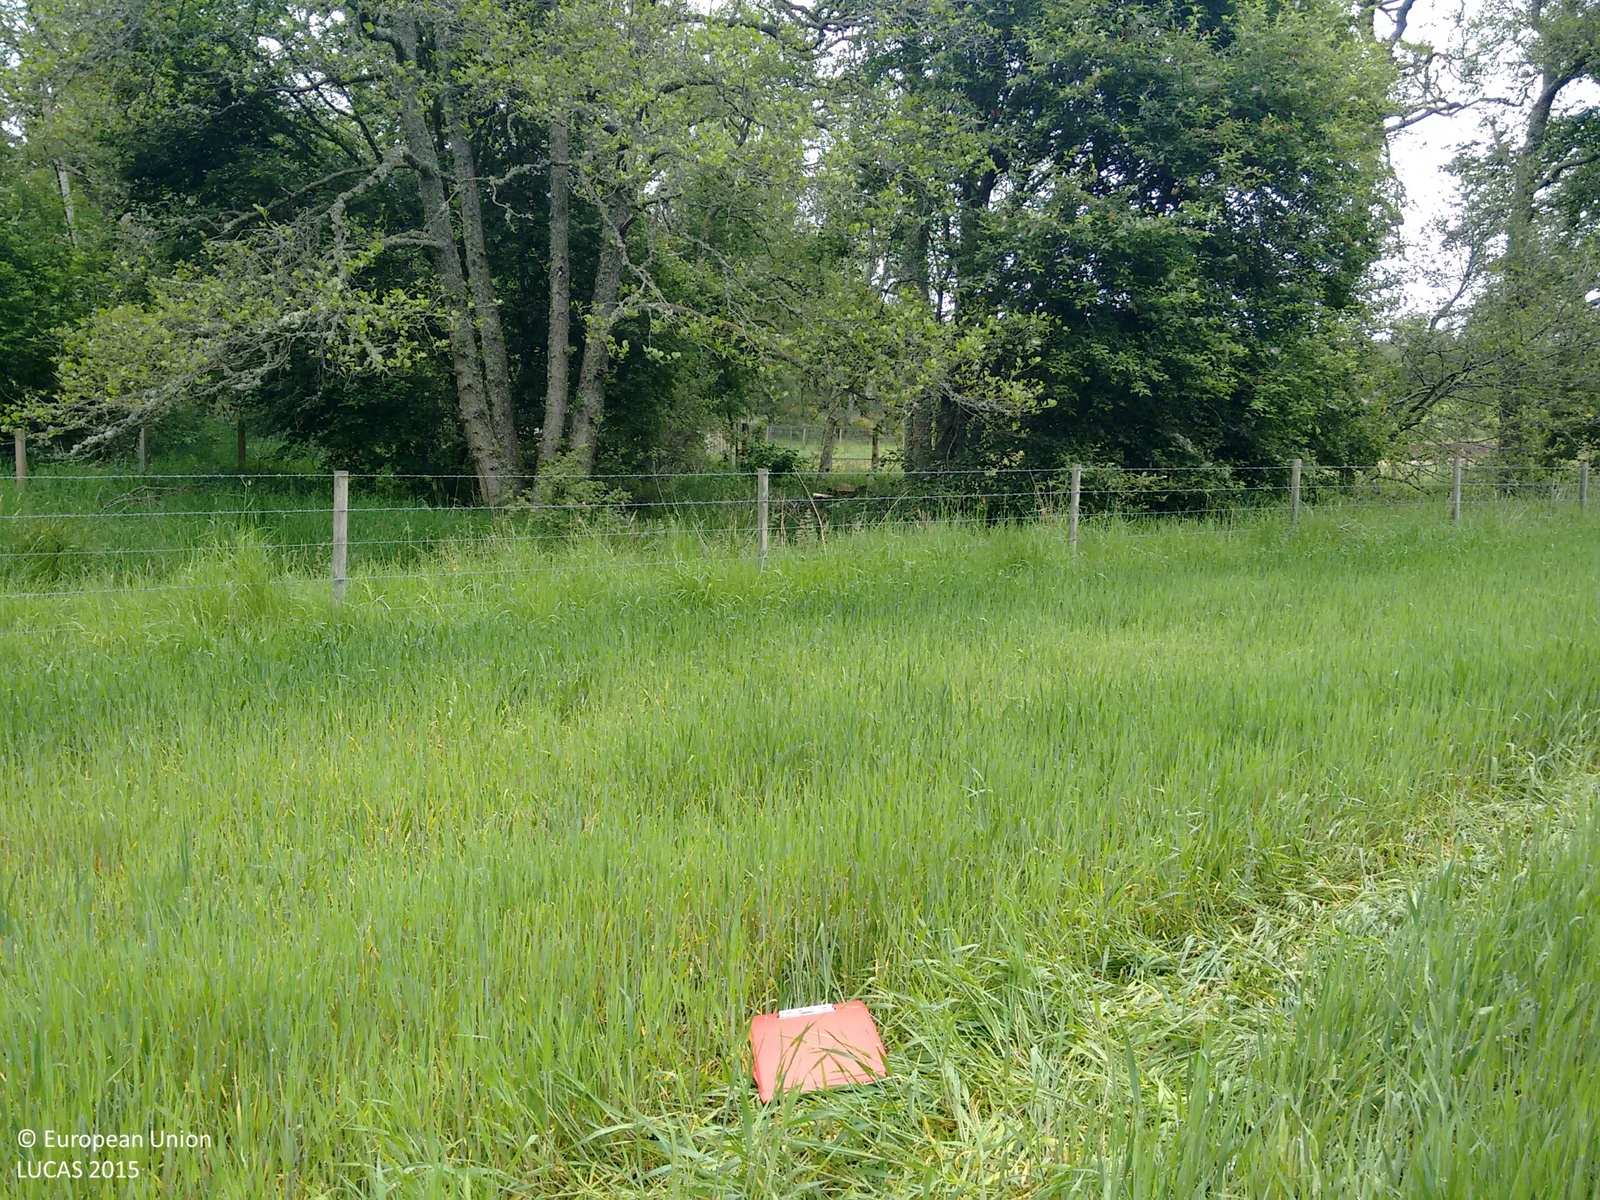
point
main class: Cropland
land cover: Barley
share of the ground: > 75 %
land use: Agriculture (excluding fallow land and kitchen gardens)
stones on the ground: < 10 %
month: June
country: GB
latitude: 57.0515
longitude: -2.6690
